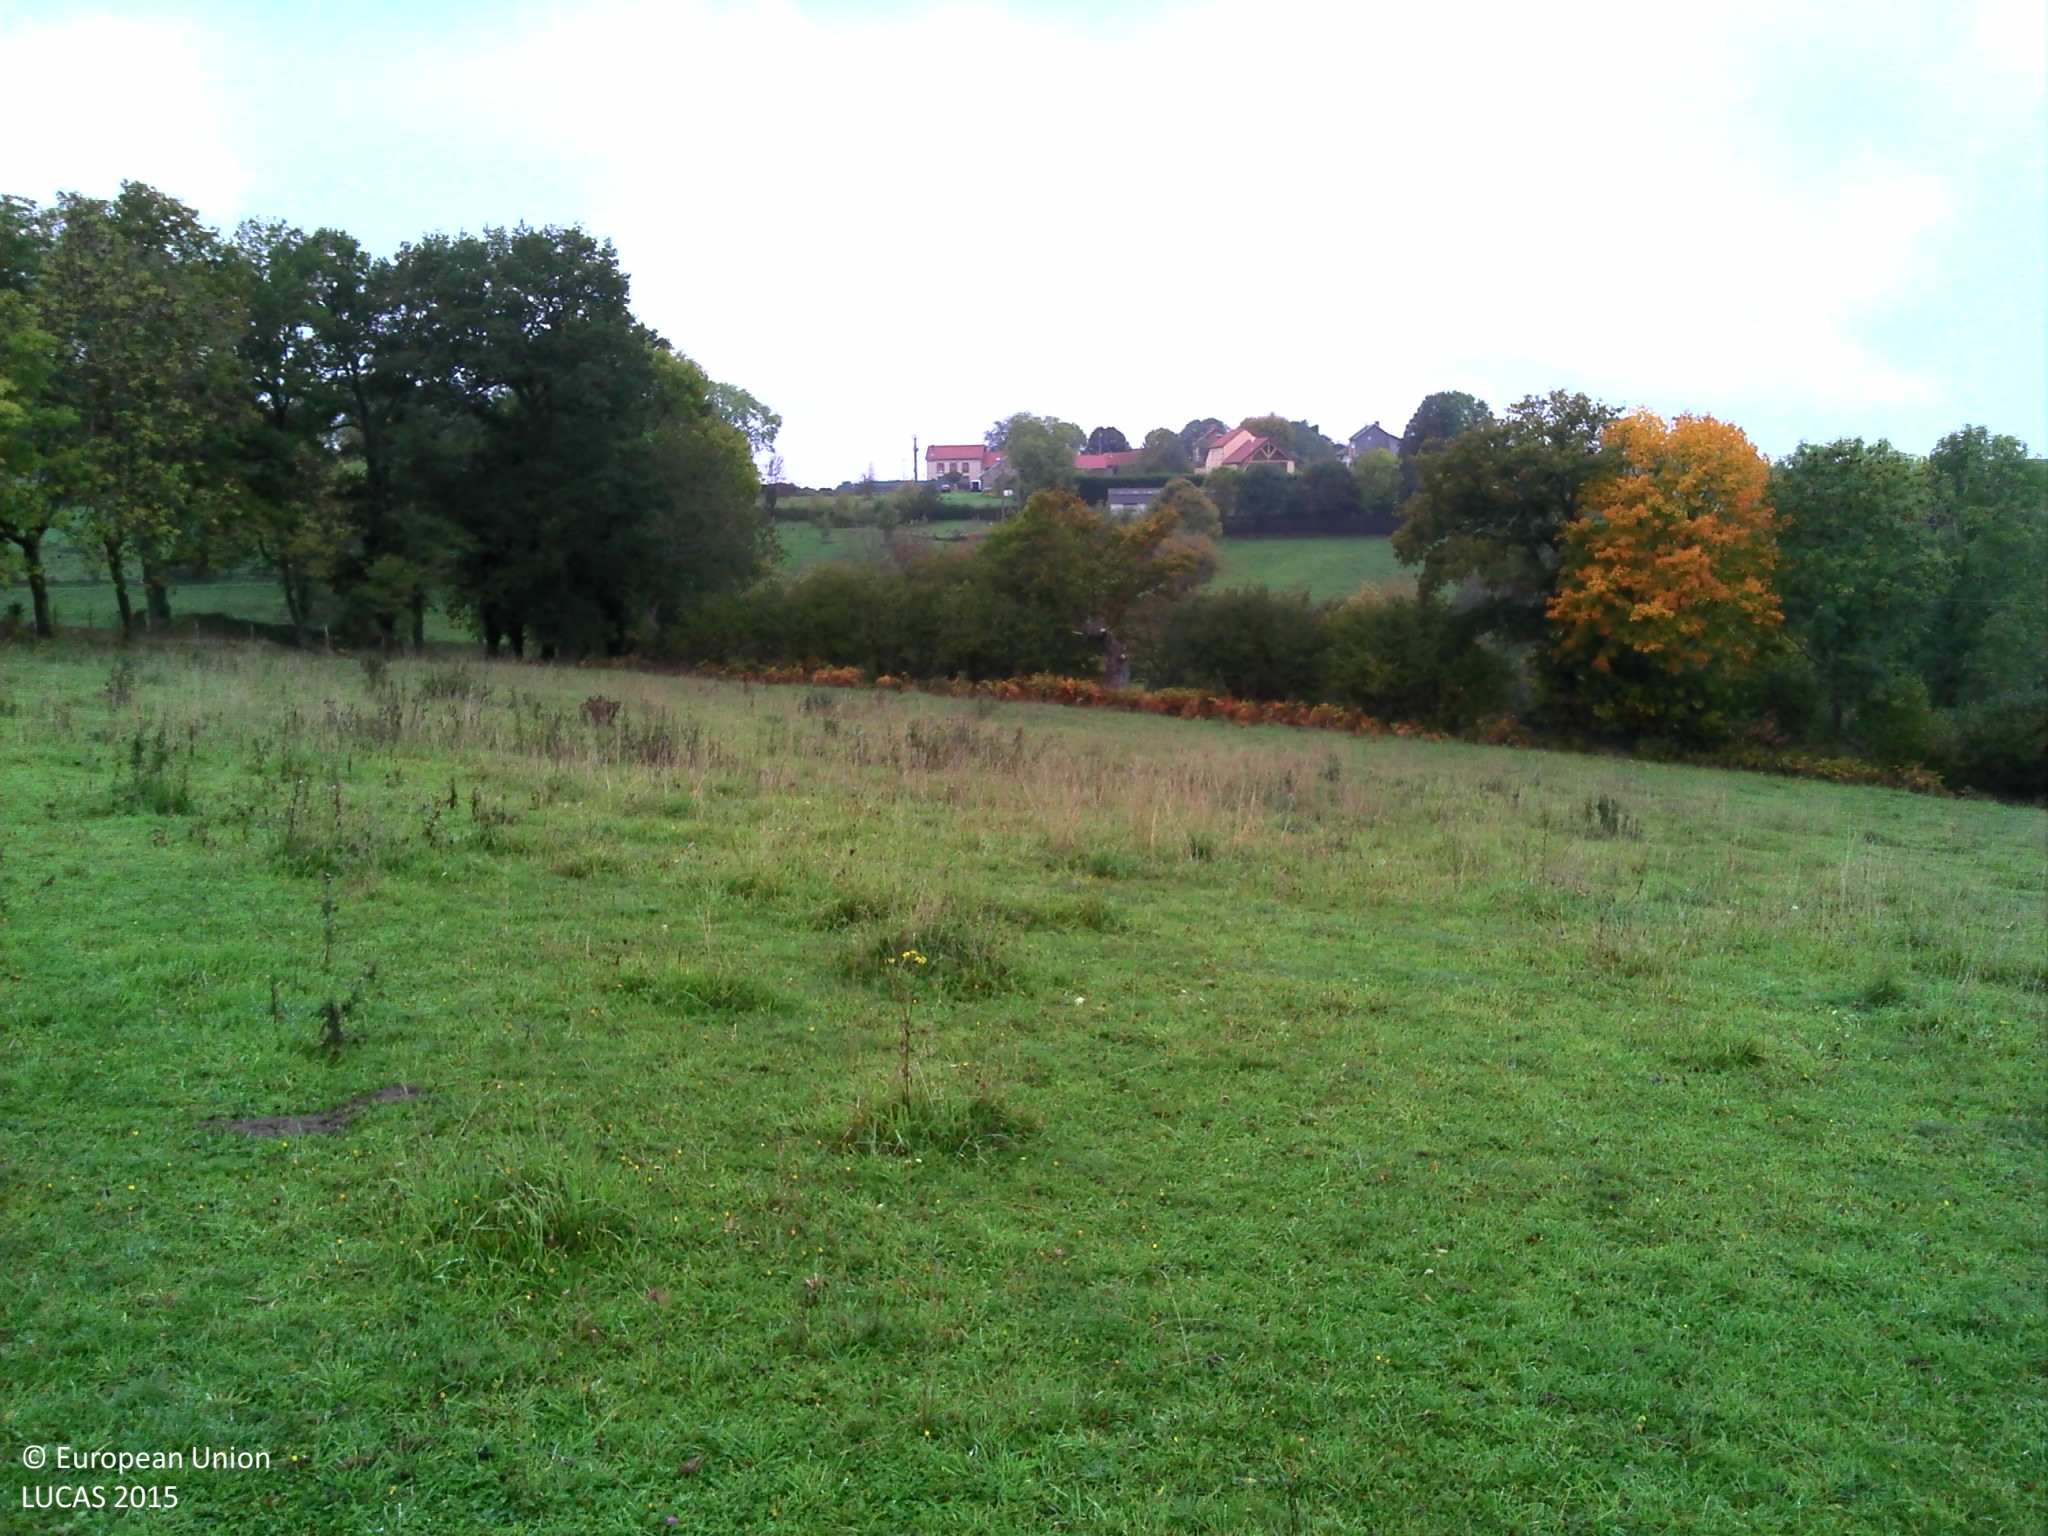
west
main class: Grassland
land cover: Grassland without tree/shrub cover
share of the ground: > 75 %
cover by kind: herbaceous plants 100 %
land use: Agriculture (excluding fallow land and kitchen gardens)
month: October
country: FR
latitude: 45.9662
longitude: 2.8361
